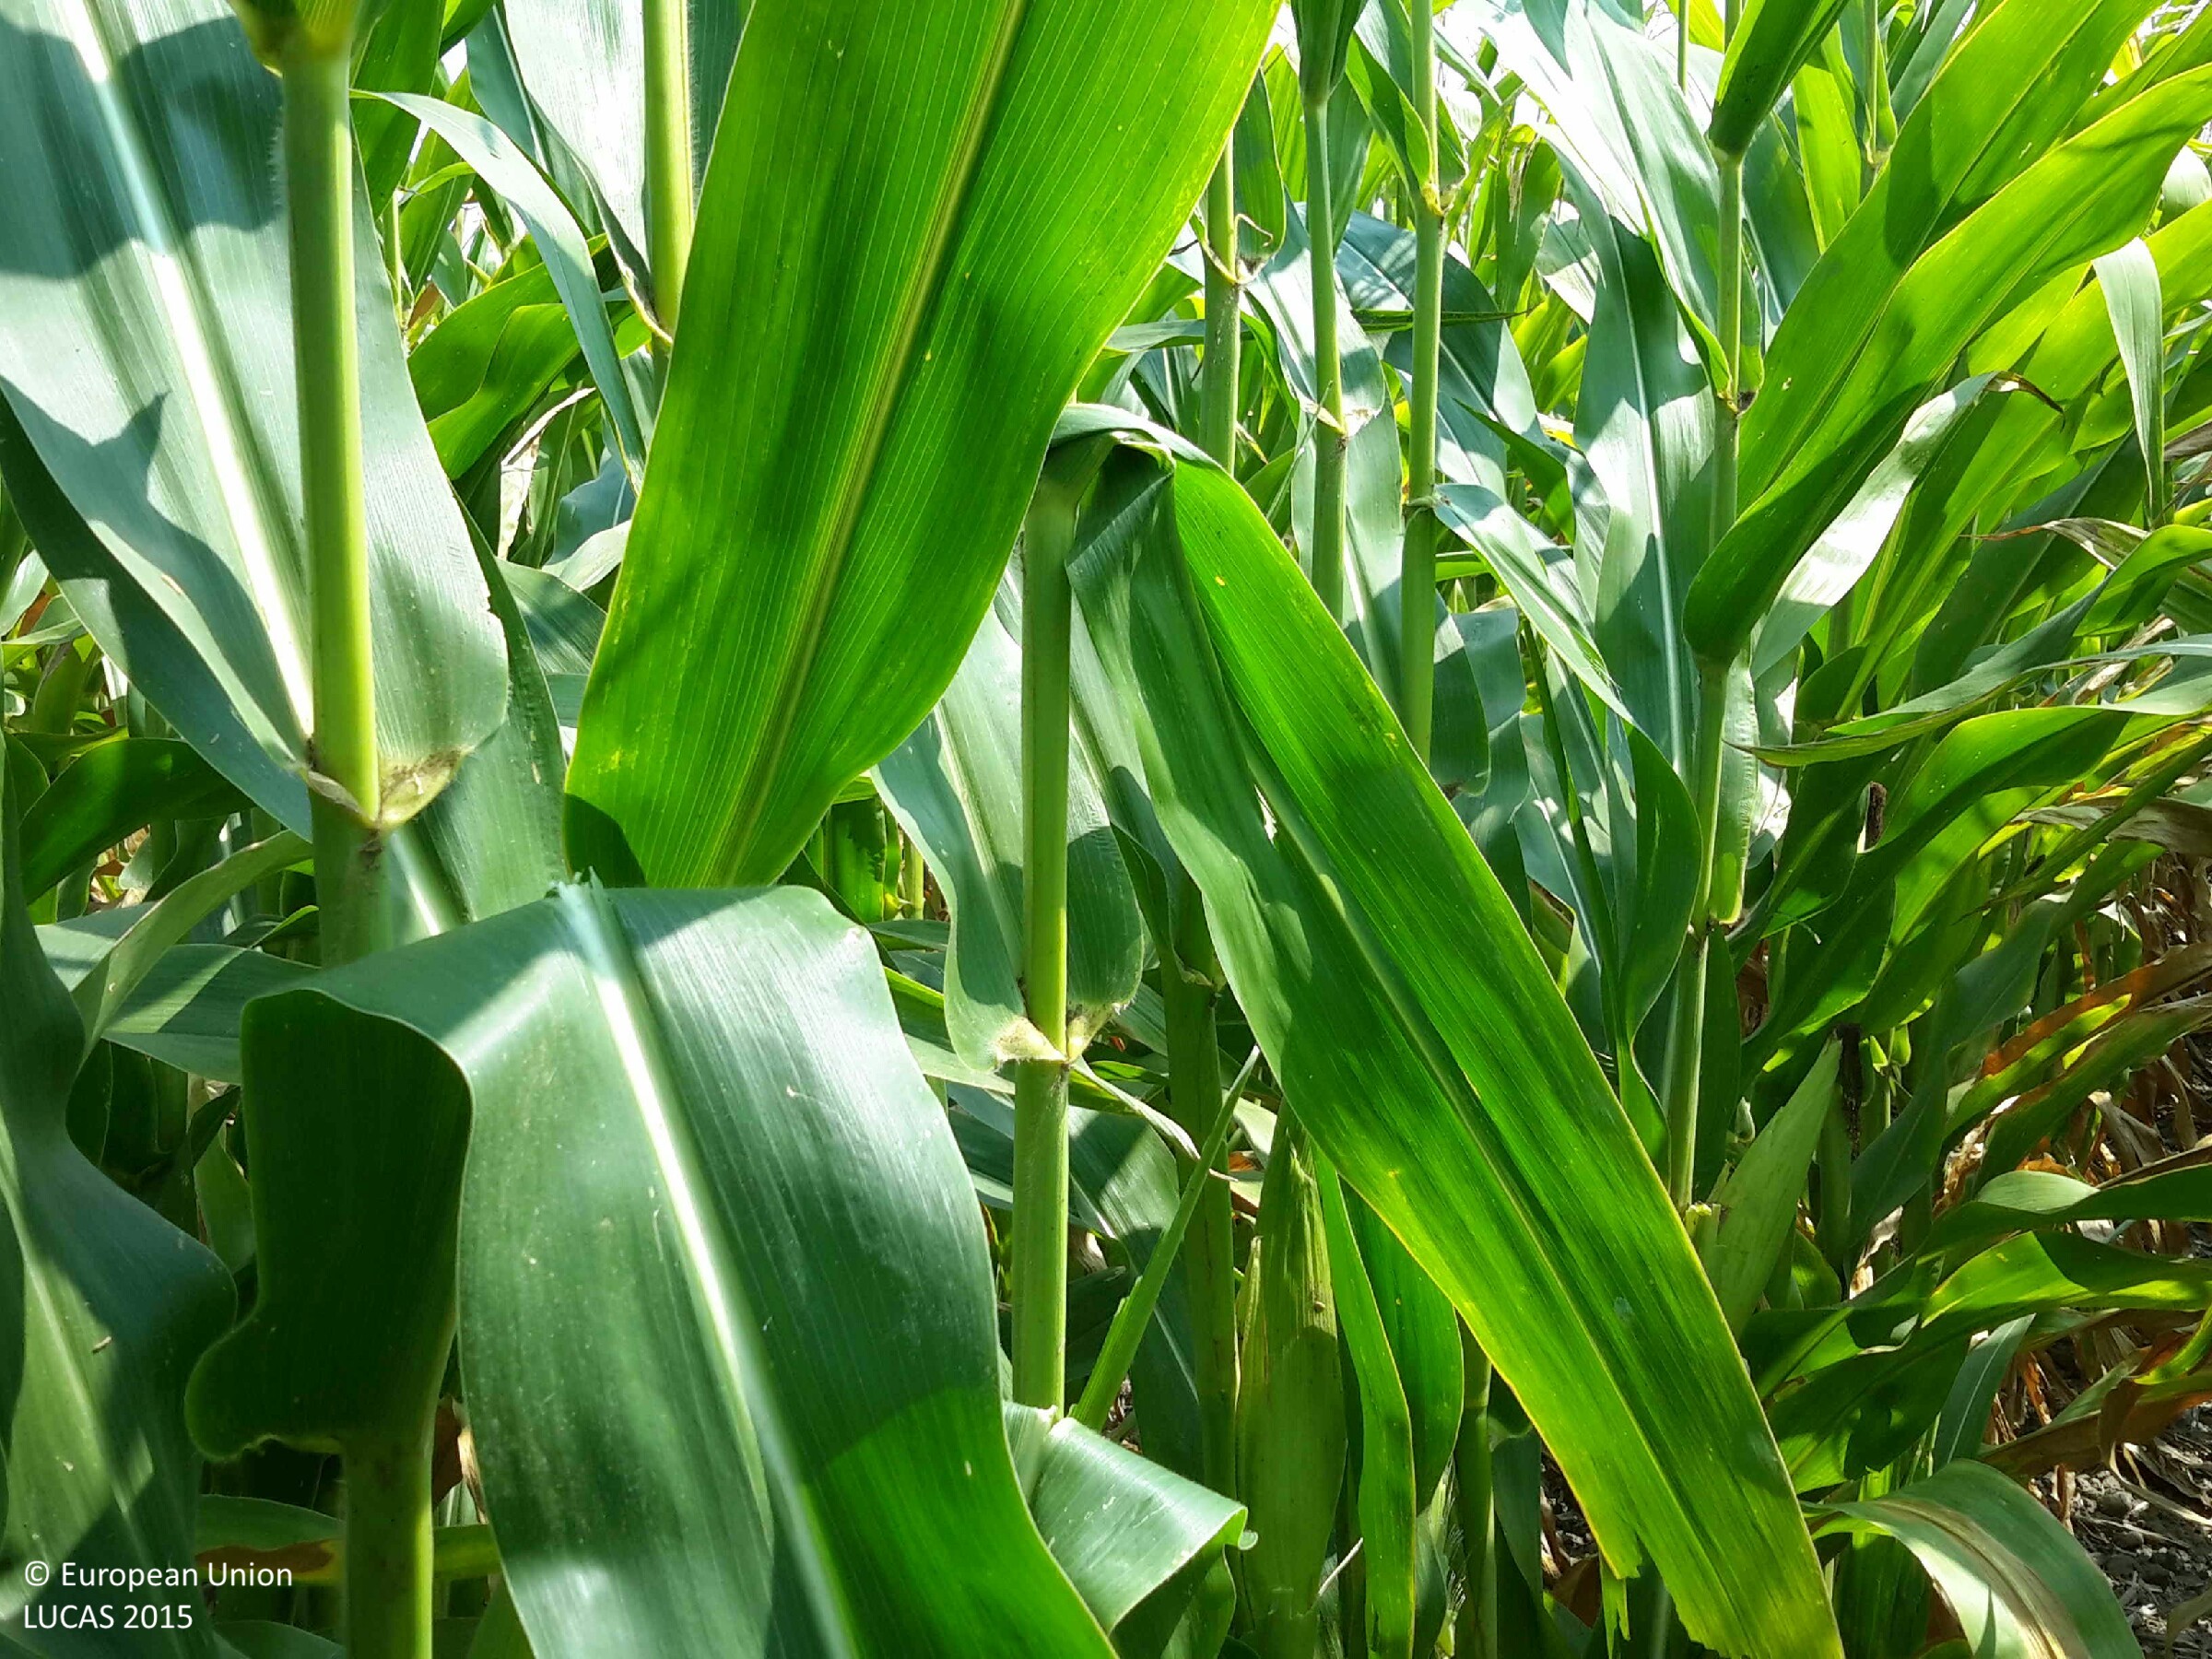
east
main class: Cropland
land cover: Maize
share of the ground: > 75 %
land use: Agriculture (excluding fallow land and kitchen gardens)
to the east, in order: Maize
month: August
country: HU
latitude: 47.8304
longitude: 17.3960
